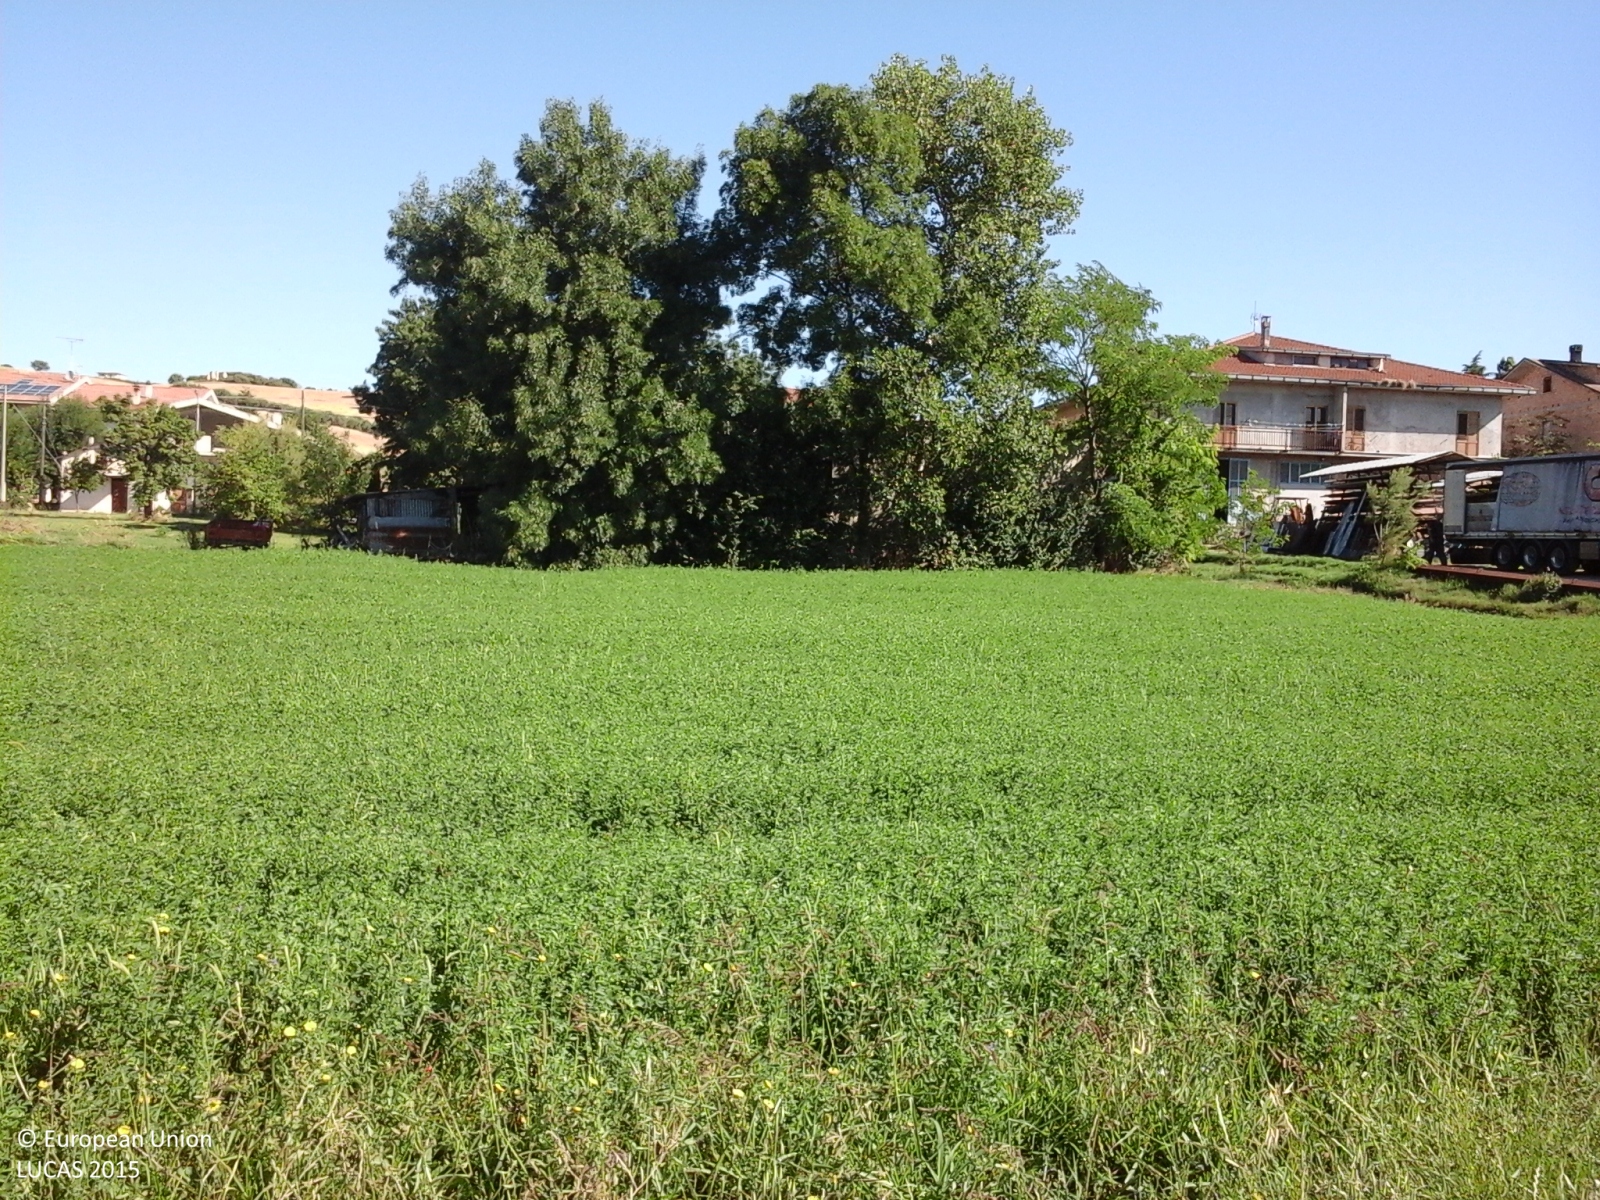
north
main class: Cropland
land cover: Other leguminous and mixtures for fodder
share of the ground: > 75 %
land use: Agriculture (excluding fallow land and kitchen gardens)
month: June
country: IT
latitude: 42.1264
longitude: 14.3532
